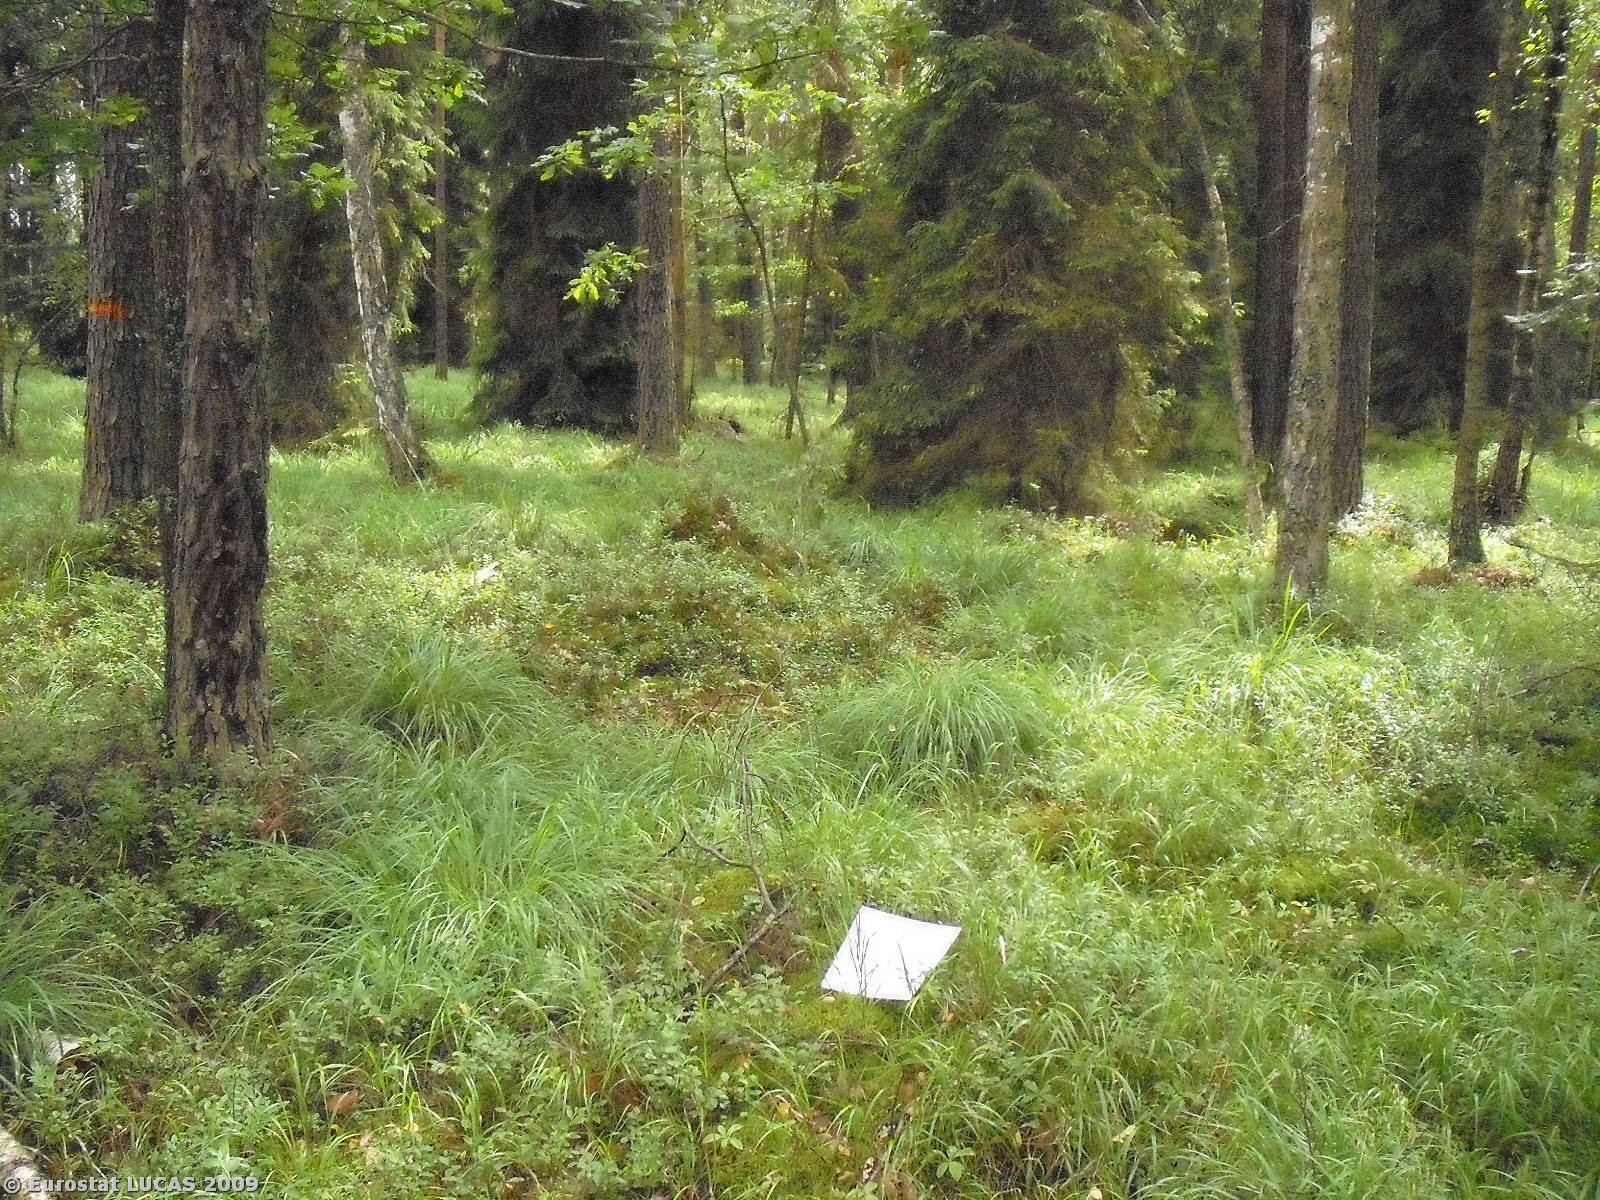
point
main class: Woodland
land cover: Mixed woodland
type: mesophytic deciduous forest
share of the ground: > 75 %
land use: Forestry
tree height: > 5 m
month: July
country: PL
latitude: 51.0368
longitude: 20.9246
